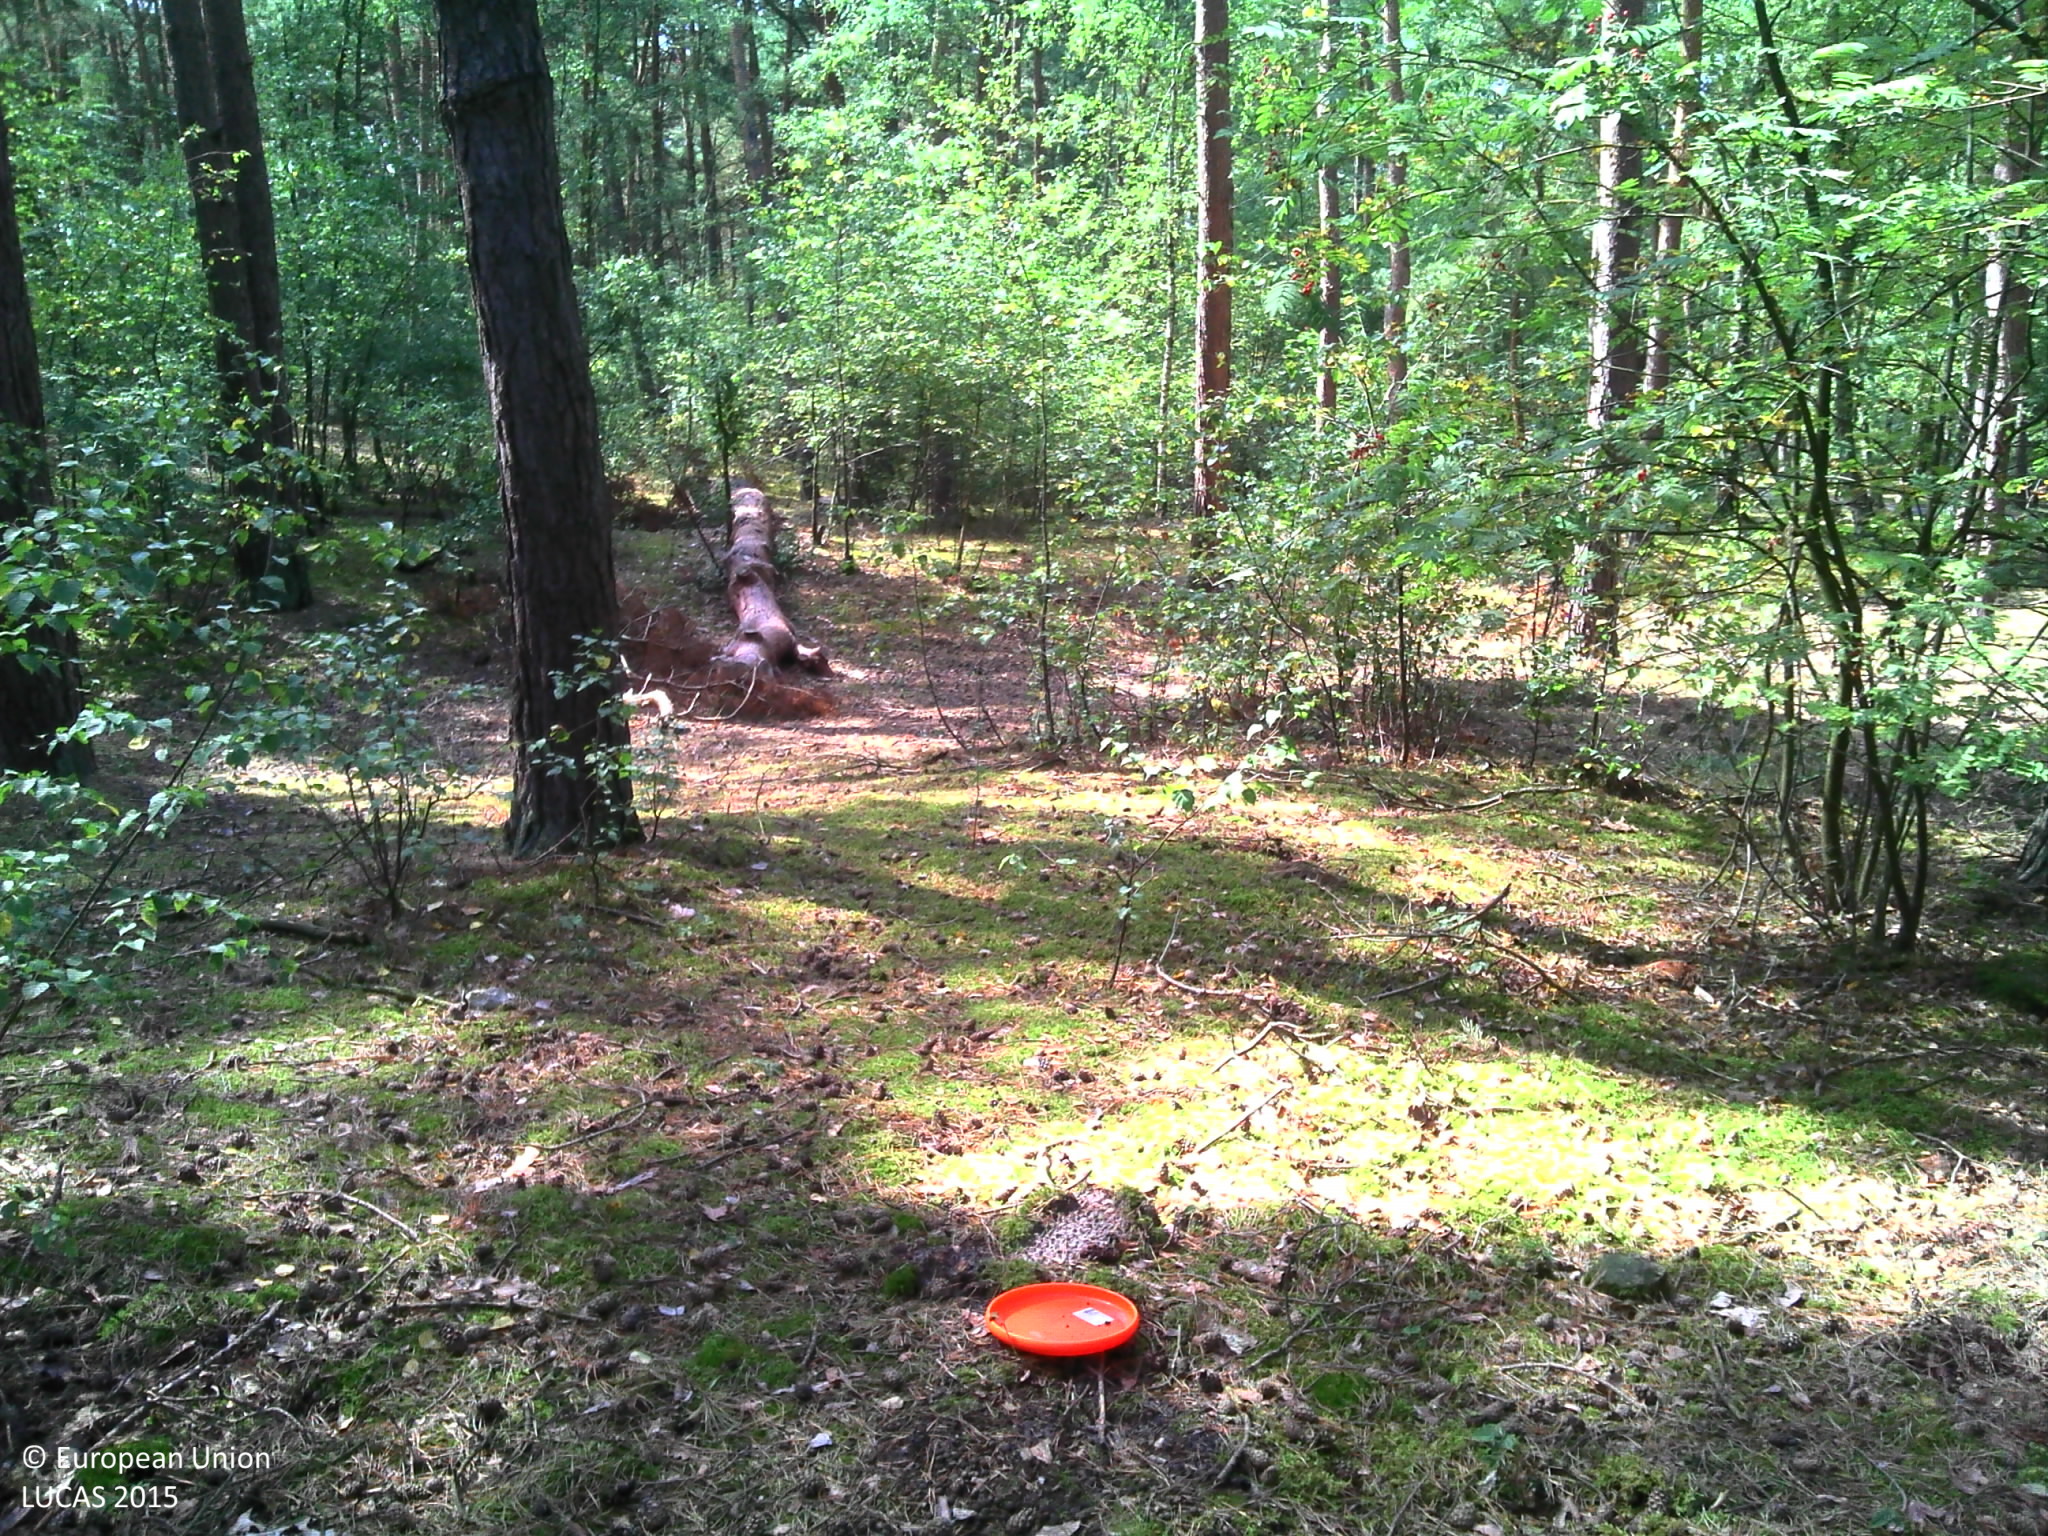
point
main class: Woodland
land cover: Pine dominated coniferous woodland
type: exotic forest
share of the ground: > 75 %
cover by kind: coniferous forest trees 90 %, broadleaved forest trees 5 %, lichens and mosses 5 %
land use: Amenities, museums, leisure
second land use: Residential
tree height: > 5 m
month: August
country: BE
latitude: 51.2168
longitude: 5.1727
